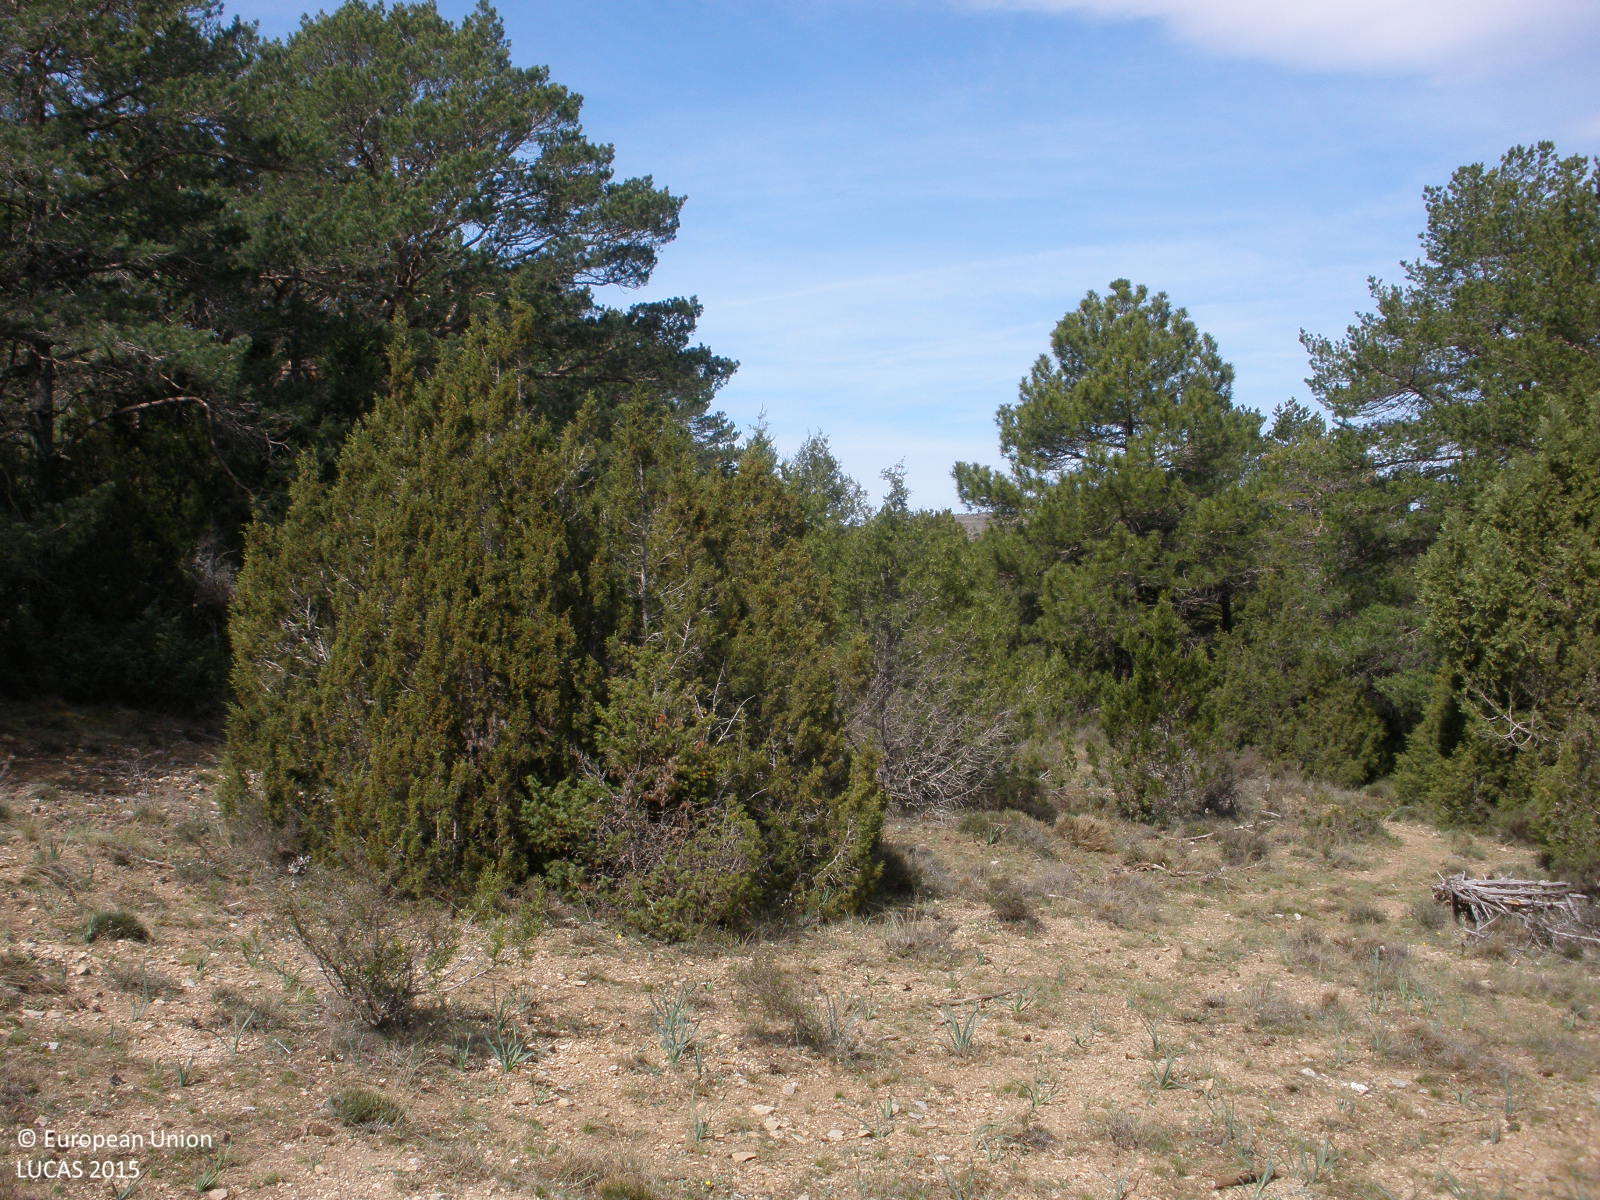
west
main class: Woodland
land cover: Pine dominated coniferous woodland
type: coniferous forest of the mediterranean region
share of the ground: > 75 %
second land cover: Grassland without tree/shrub cover
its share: > 75 %
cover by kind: coniferous forest trees 40 %, shrubs 30 %, herbaceous plants 20 %, consolidated bare surface 10 %
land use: Forestry
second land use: Agriculture (excluding fallow land and kitchen gardens)
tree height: > 5 m
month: April
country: ES
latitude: 40.2156
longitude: -0.9714
